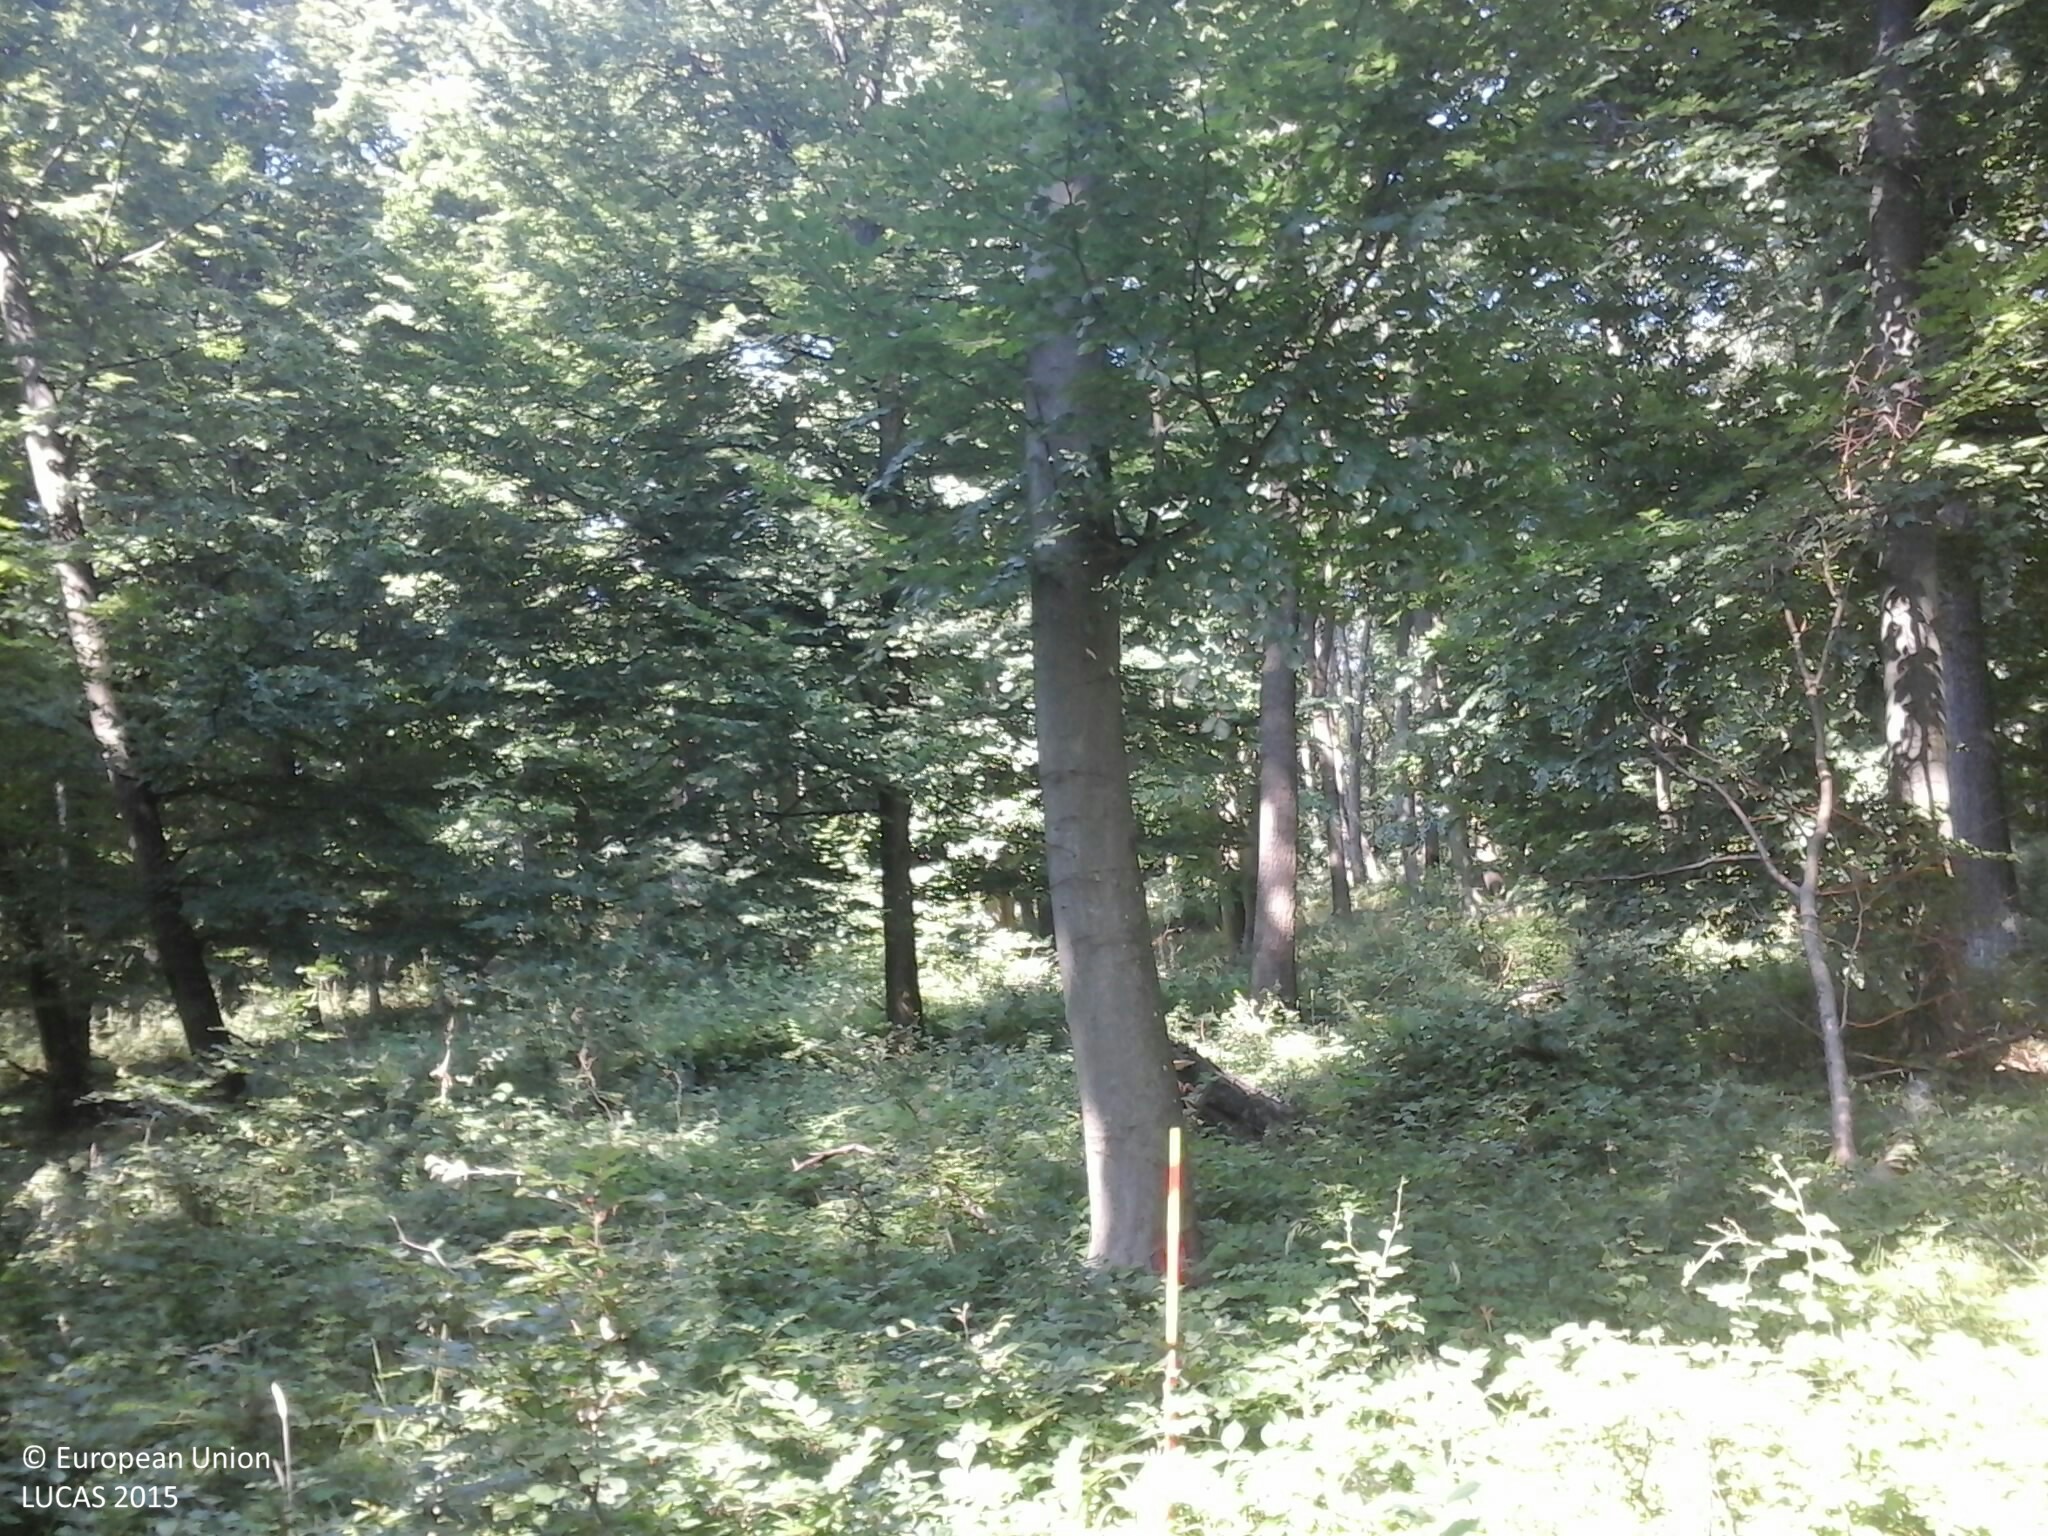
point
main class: Woodland
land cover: Broadleaved woodland
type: beech forest
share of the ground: > 75 %
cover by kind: broadleaved forest trees 95 %, herbaceous plants 5 %
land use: Forestry
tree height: > 5 m
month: July
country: HU
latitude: 47.1672
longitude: 17.8318
